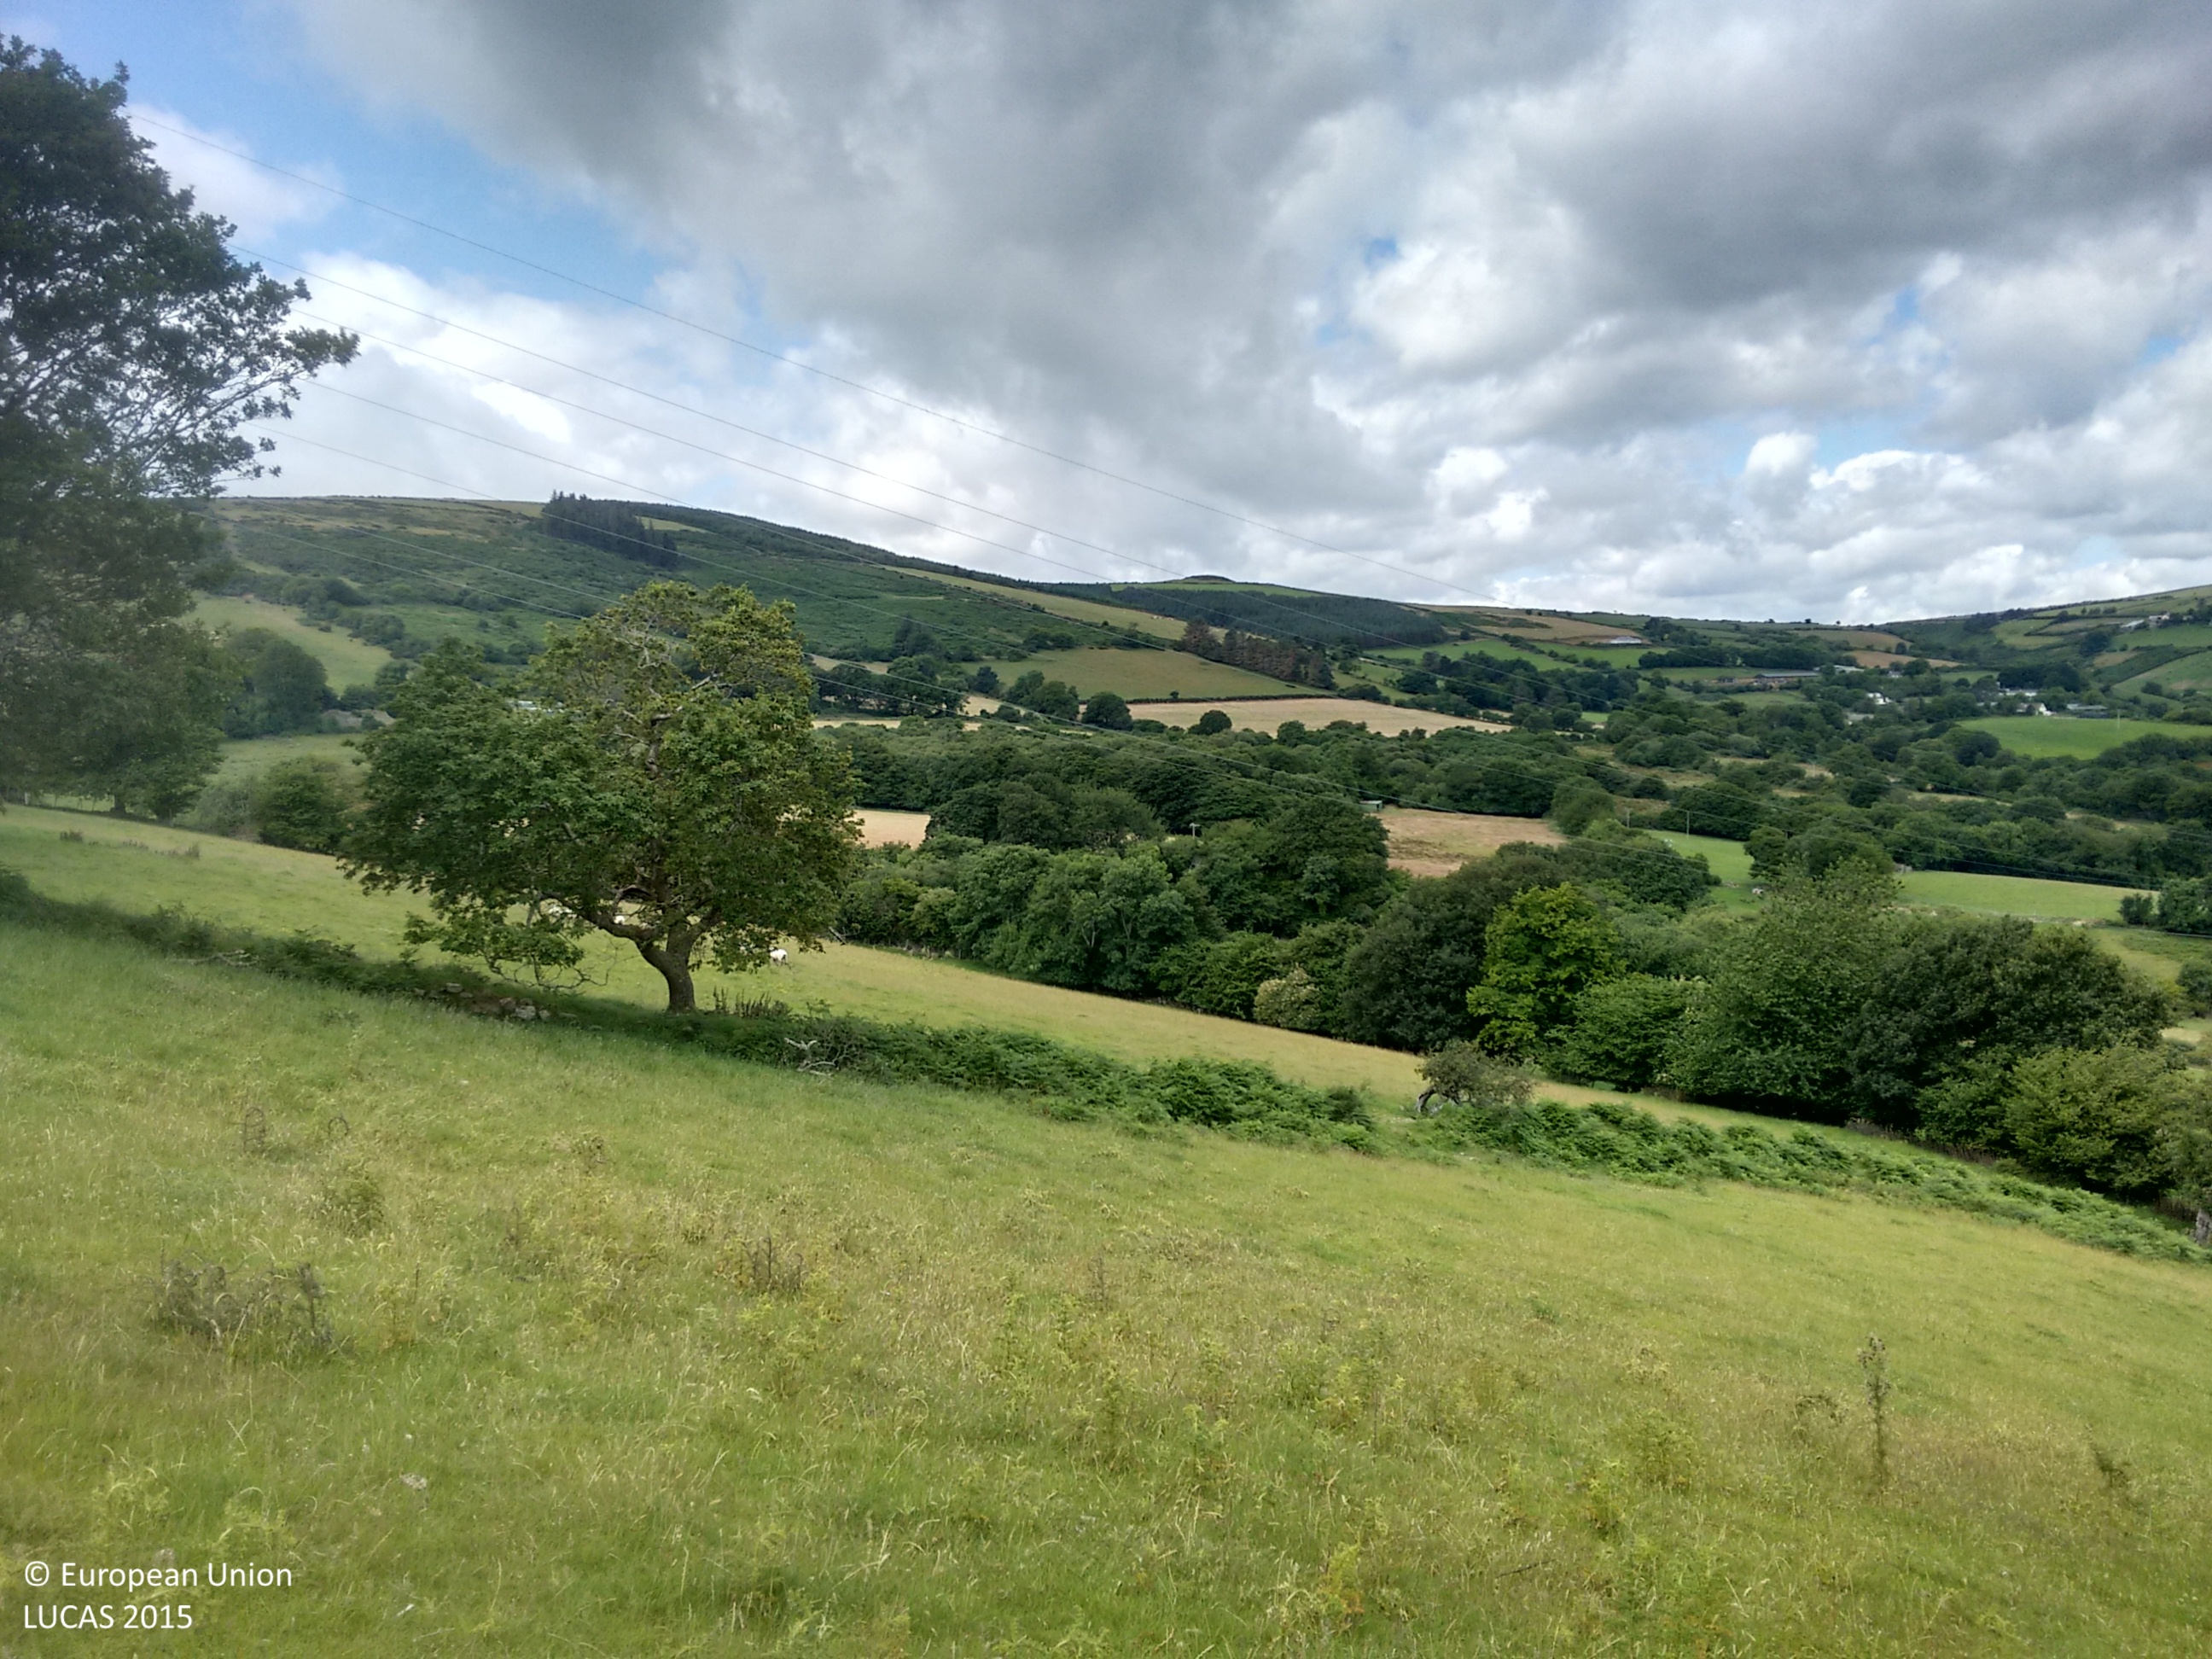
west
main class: Grassland
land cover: Grassland without tree/shrub cover
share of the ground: > 75 %
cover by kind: herbaceous plants 100 %
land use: Agriculture (excluding fallow land and kitchen gardens)
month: July
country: IE
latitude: 53.1369
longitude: -6.1256
